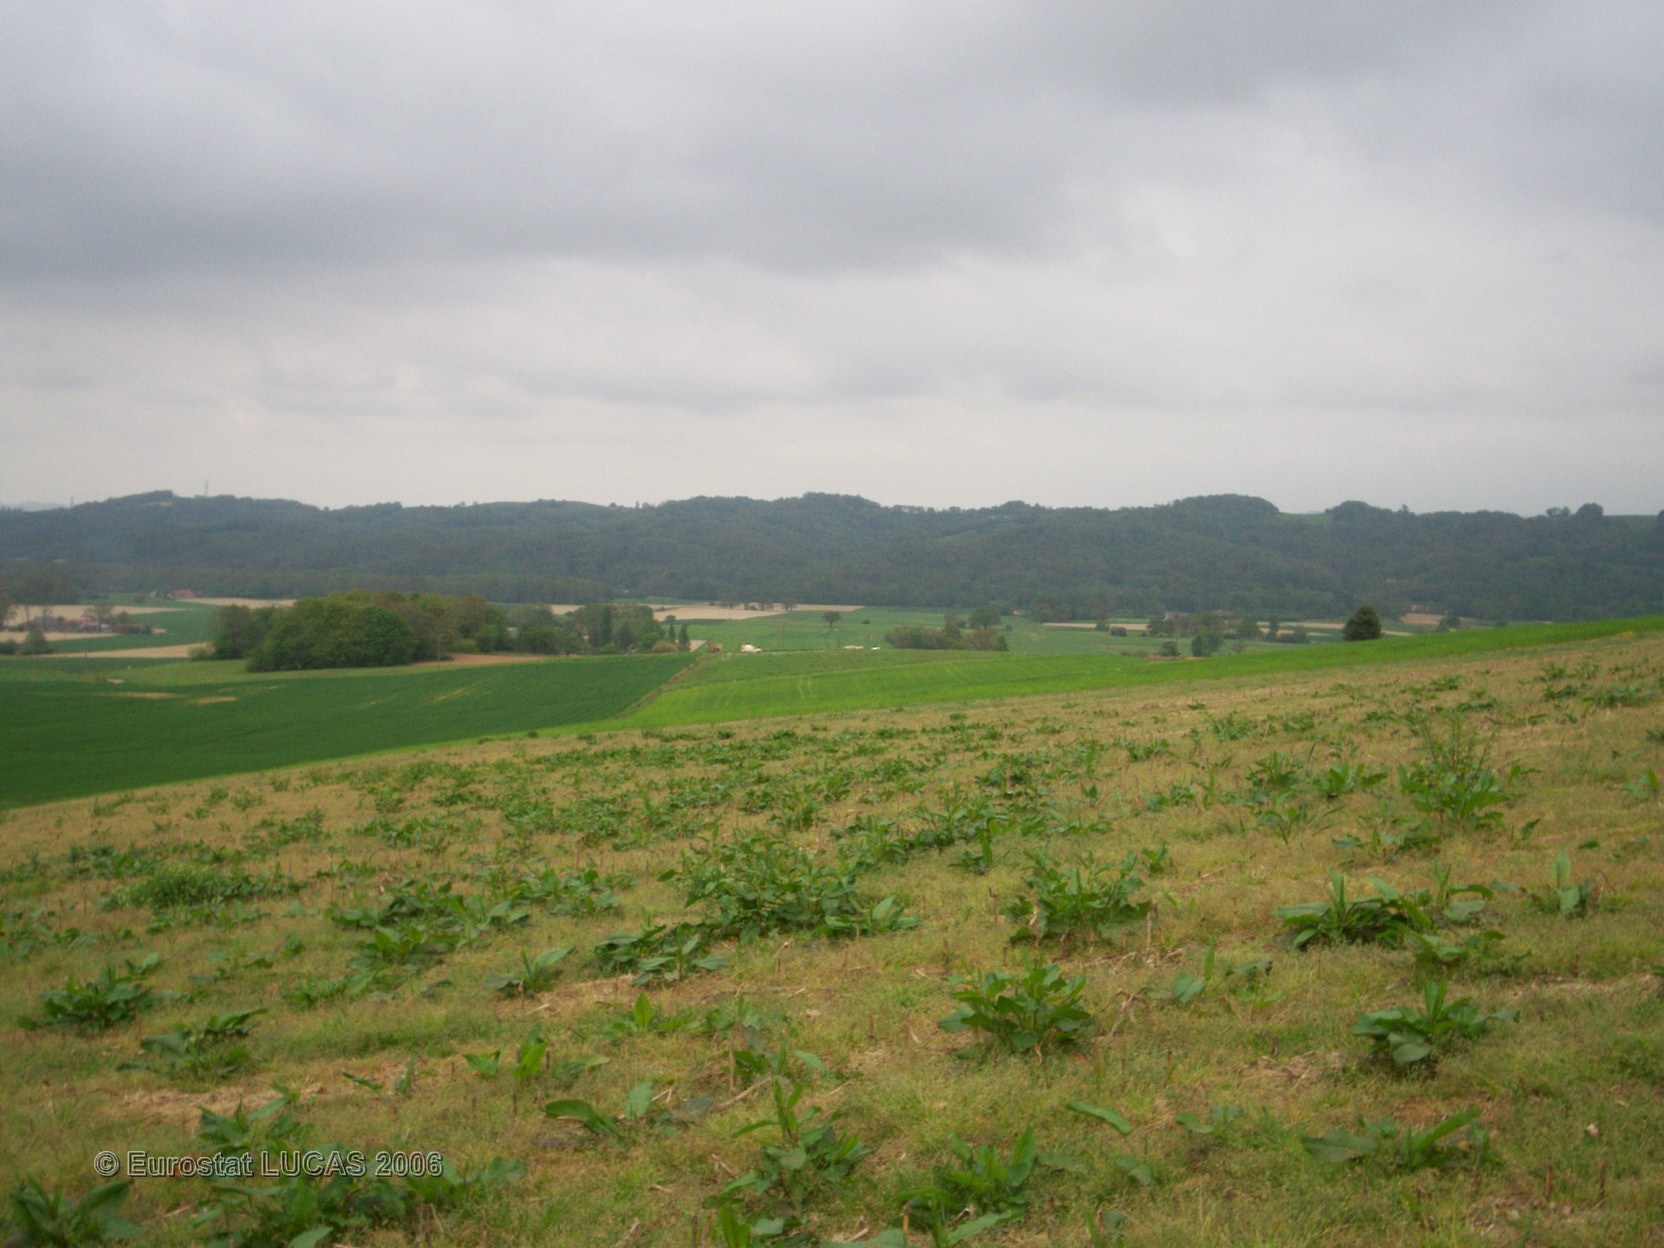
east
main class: Grassland
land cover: Grassland without tree/shrub cover
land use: Agriculture (excluding fallow land and kitchen gardens)
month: April
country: FR
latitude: 43.2622
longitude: 0.3279
